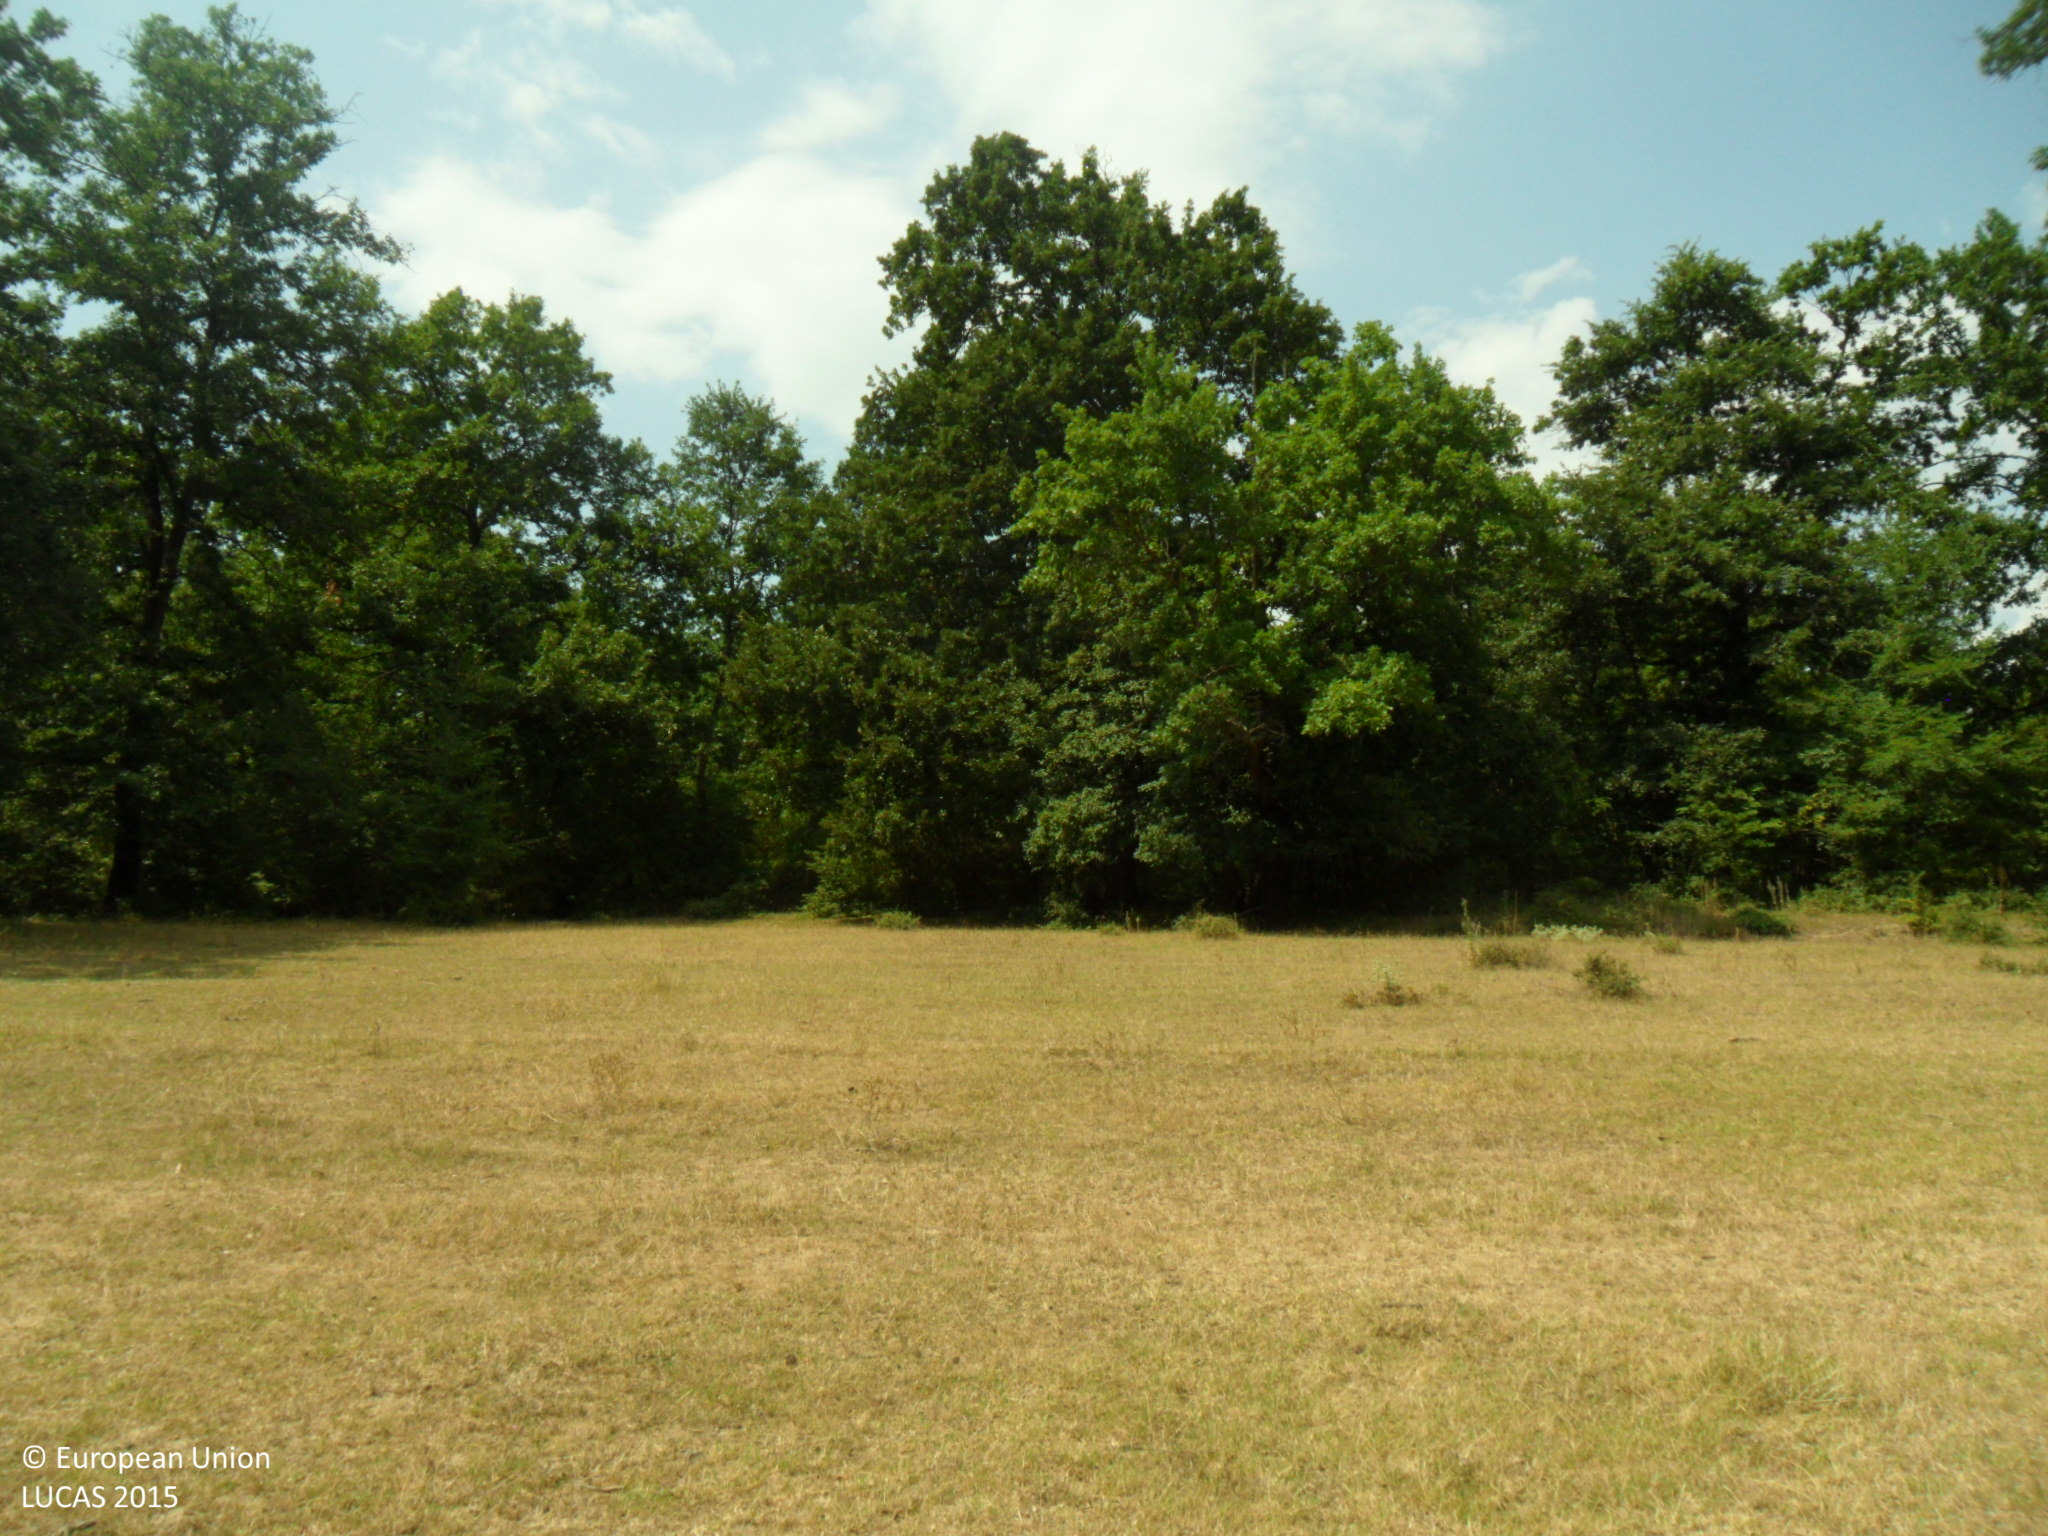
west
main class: Grassland
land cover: Grassland without tree/shrub cover
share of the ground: > 75 %
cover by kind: herbaceous plants 100 %
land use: Agriculture (excluding fallow land and kitchen gardens)
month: August
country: BG
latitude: 43.0348
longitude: 26.7357
